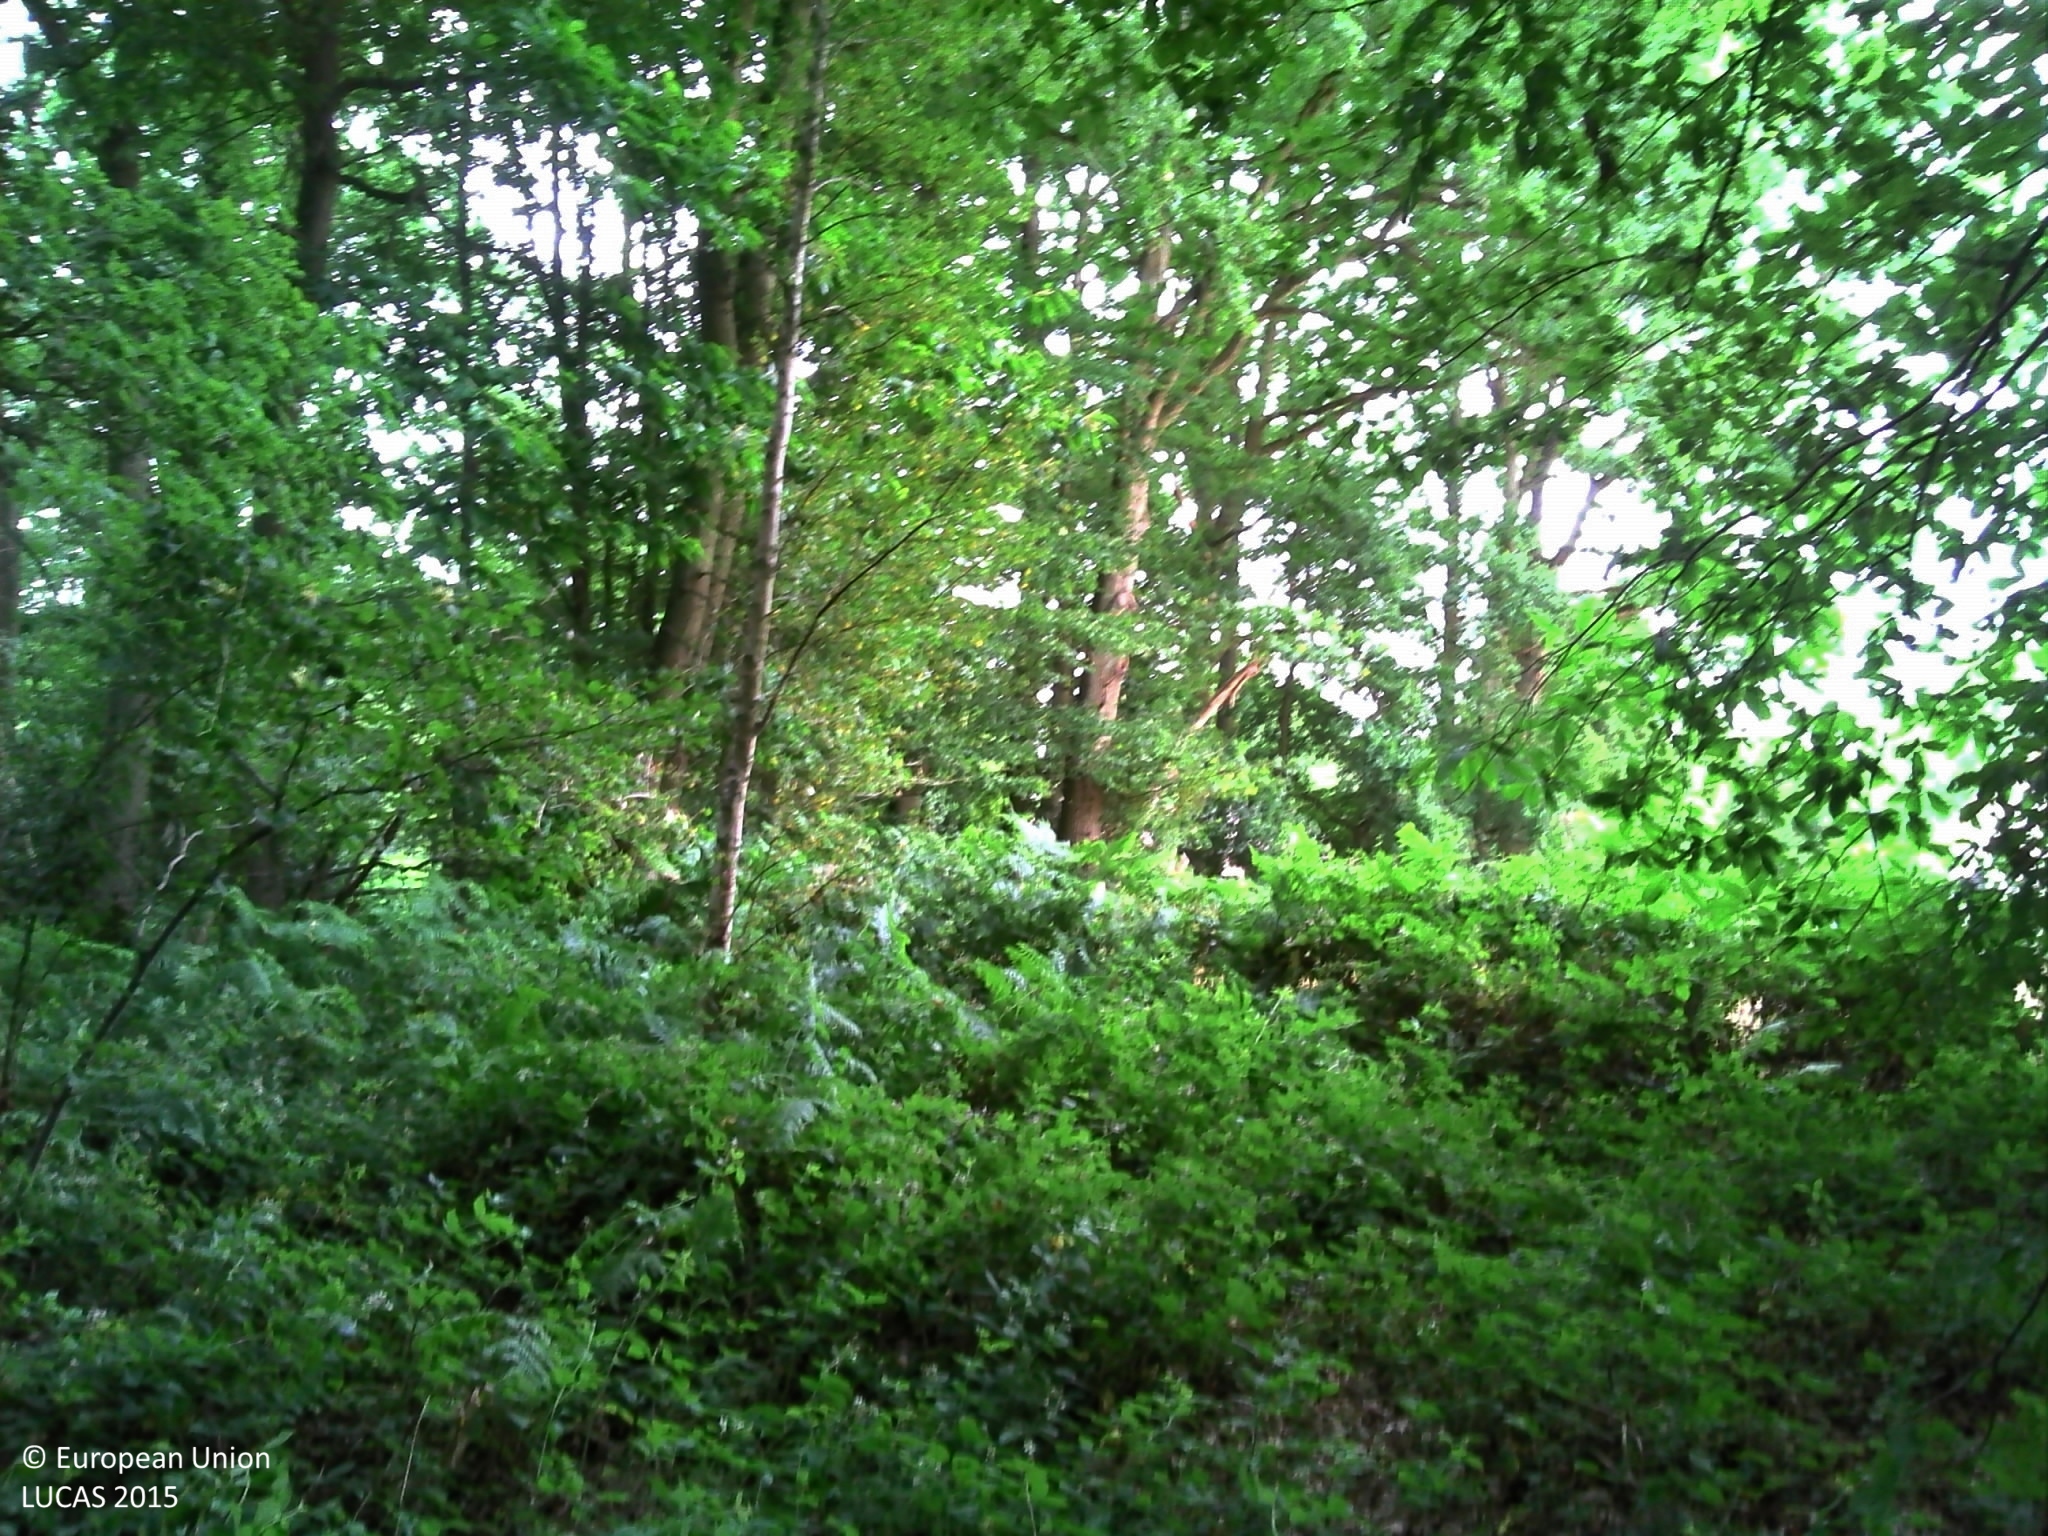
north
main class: Woodland
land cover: Broadleaved woodland
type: mesophytic deciduous forest
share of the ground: > 75 %
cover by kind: broadleaved forest trees 80 %, herbaceous plants 10 %, shrubs 5 %, unconsolidated bare surface 5 %
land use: Forestry
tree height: > 5 m
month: July
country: FR
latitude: 49.4549
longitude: 1.8031
